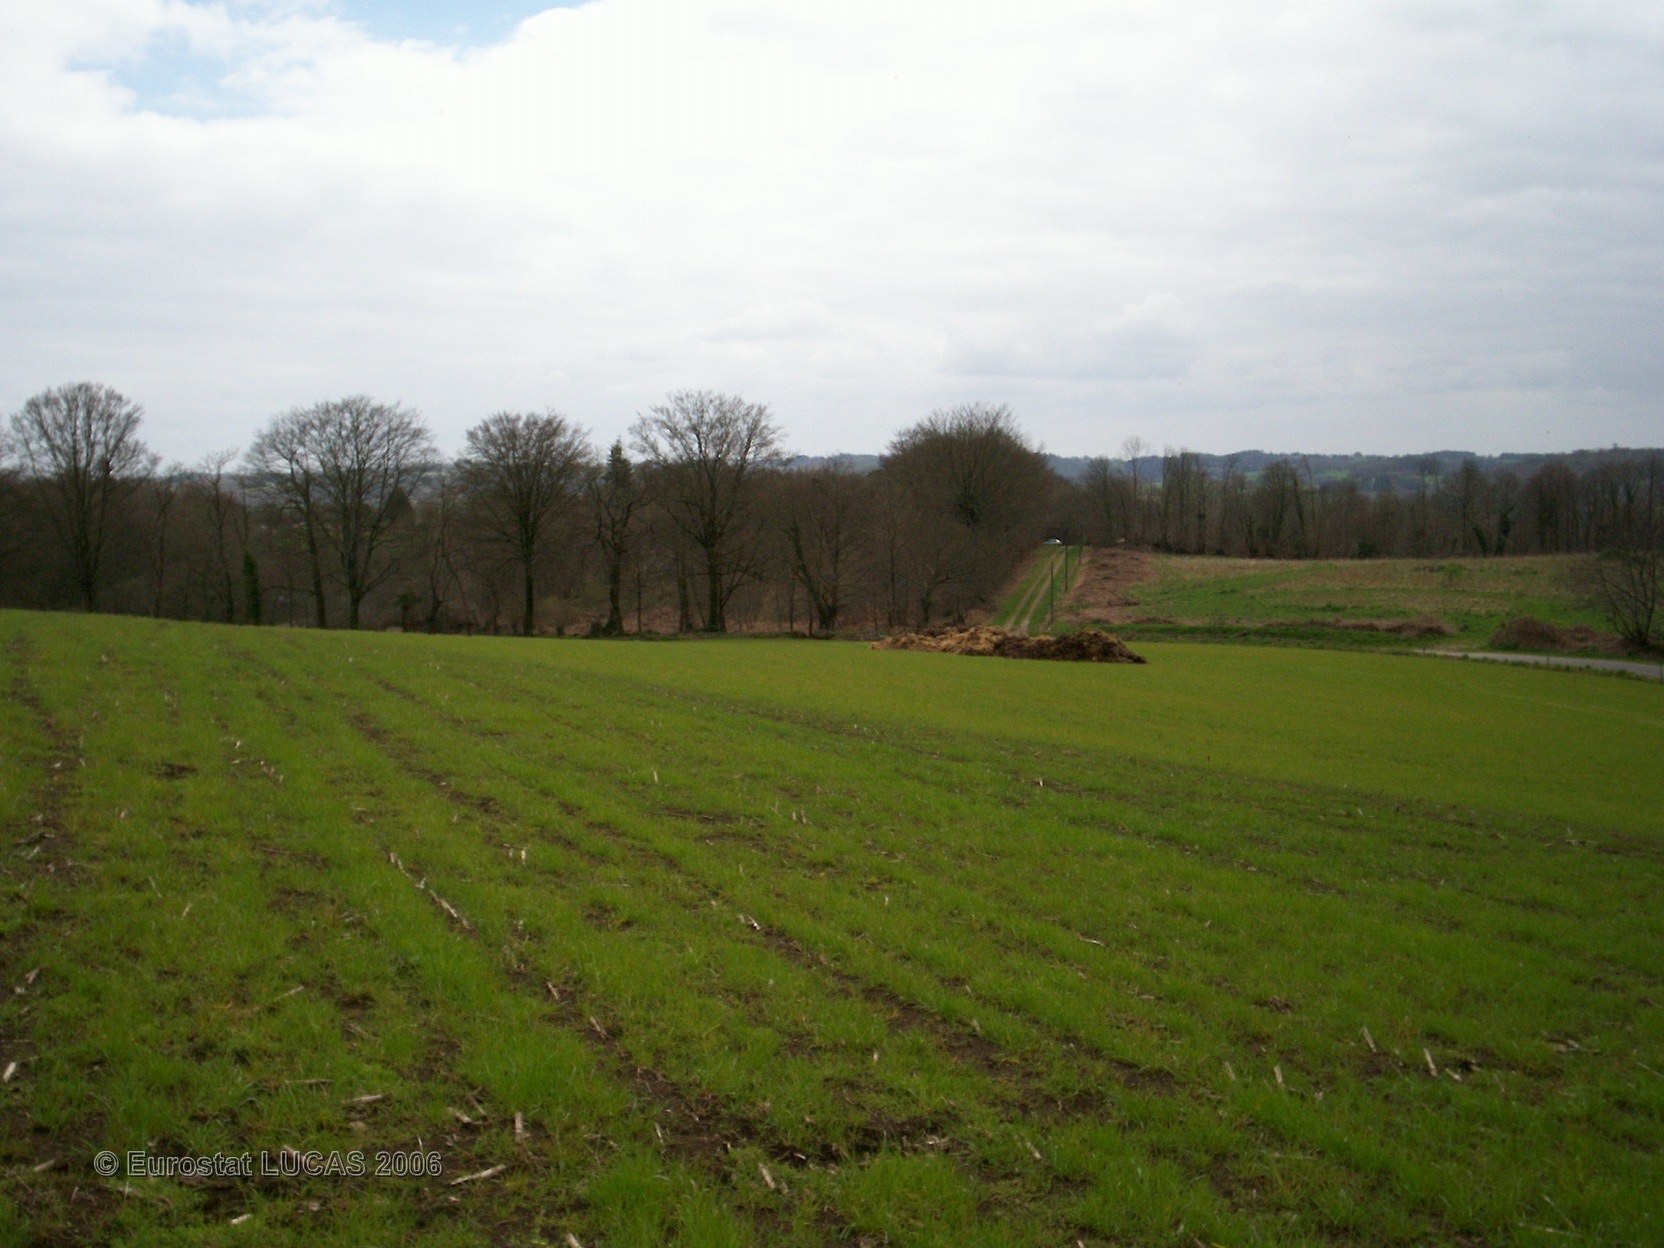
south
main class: Grassland
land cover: Grassland without tree/shrub cover
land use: Agriculture (excluding fallow land and kitchen gardens)
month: April
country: FR
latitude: 48.0027
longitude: -3.5478
